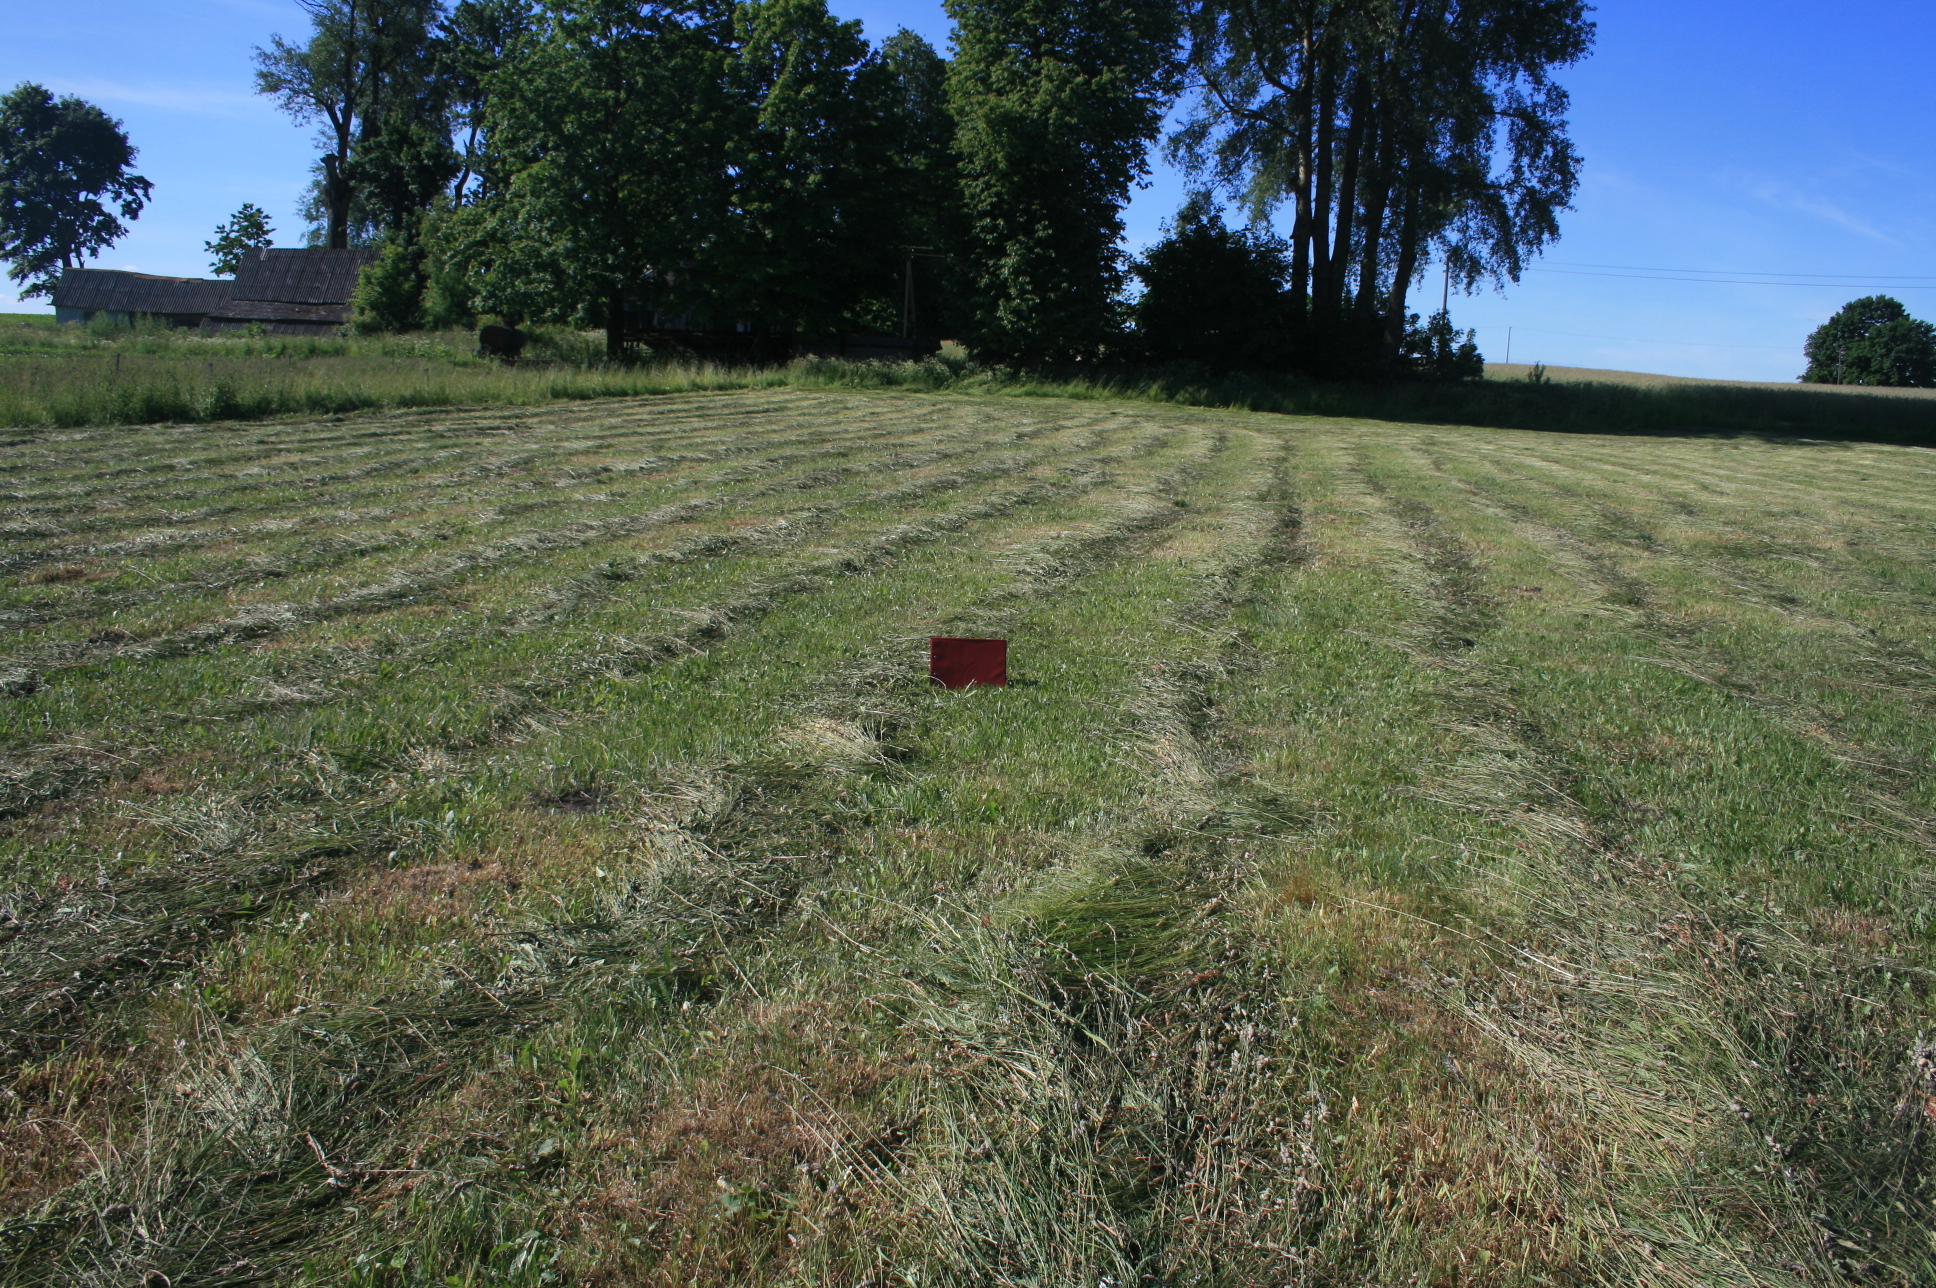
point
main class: Grassland
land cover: Grassland without tree/shrub cover
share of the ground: > 75 %
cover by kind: herbaceous plants 100 %
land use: Agriculture (excluding fallow land and kitchen gardens)
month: June
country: LT
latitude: 55.4648
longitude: 22.1231
